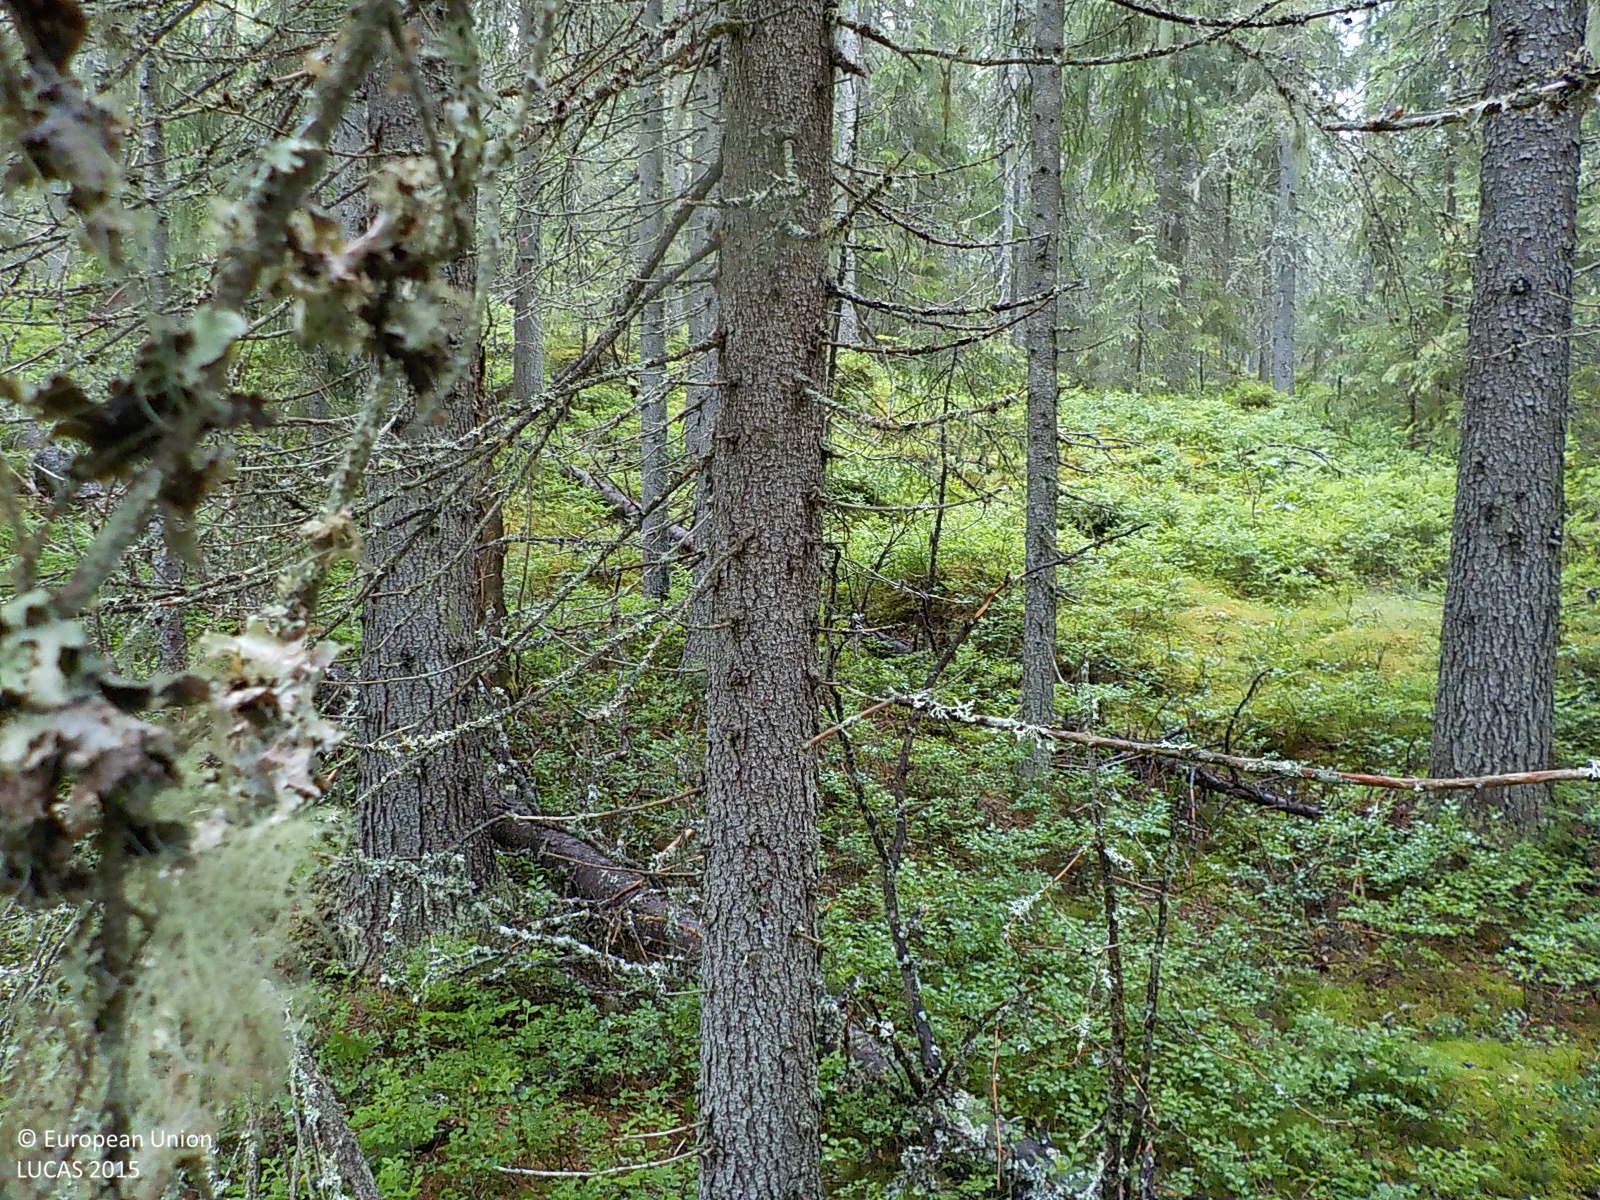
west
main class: Woodland
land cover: Spruce dominated coniferous woodland
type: boreal forest
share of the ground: 50 - 75 %
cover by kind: coniferous forest trees 60 %, shrubs 35 %, broadleaved forest trees 5 %
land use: Forestry
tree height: > 5 m
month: July
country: SE
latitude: 63.1963
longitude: 18.0271
